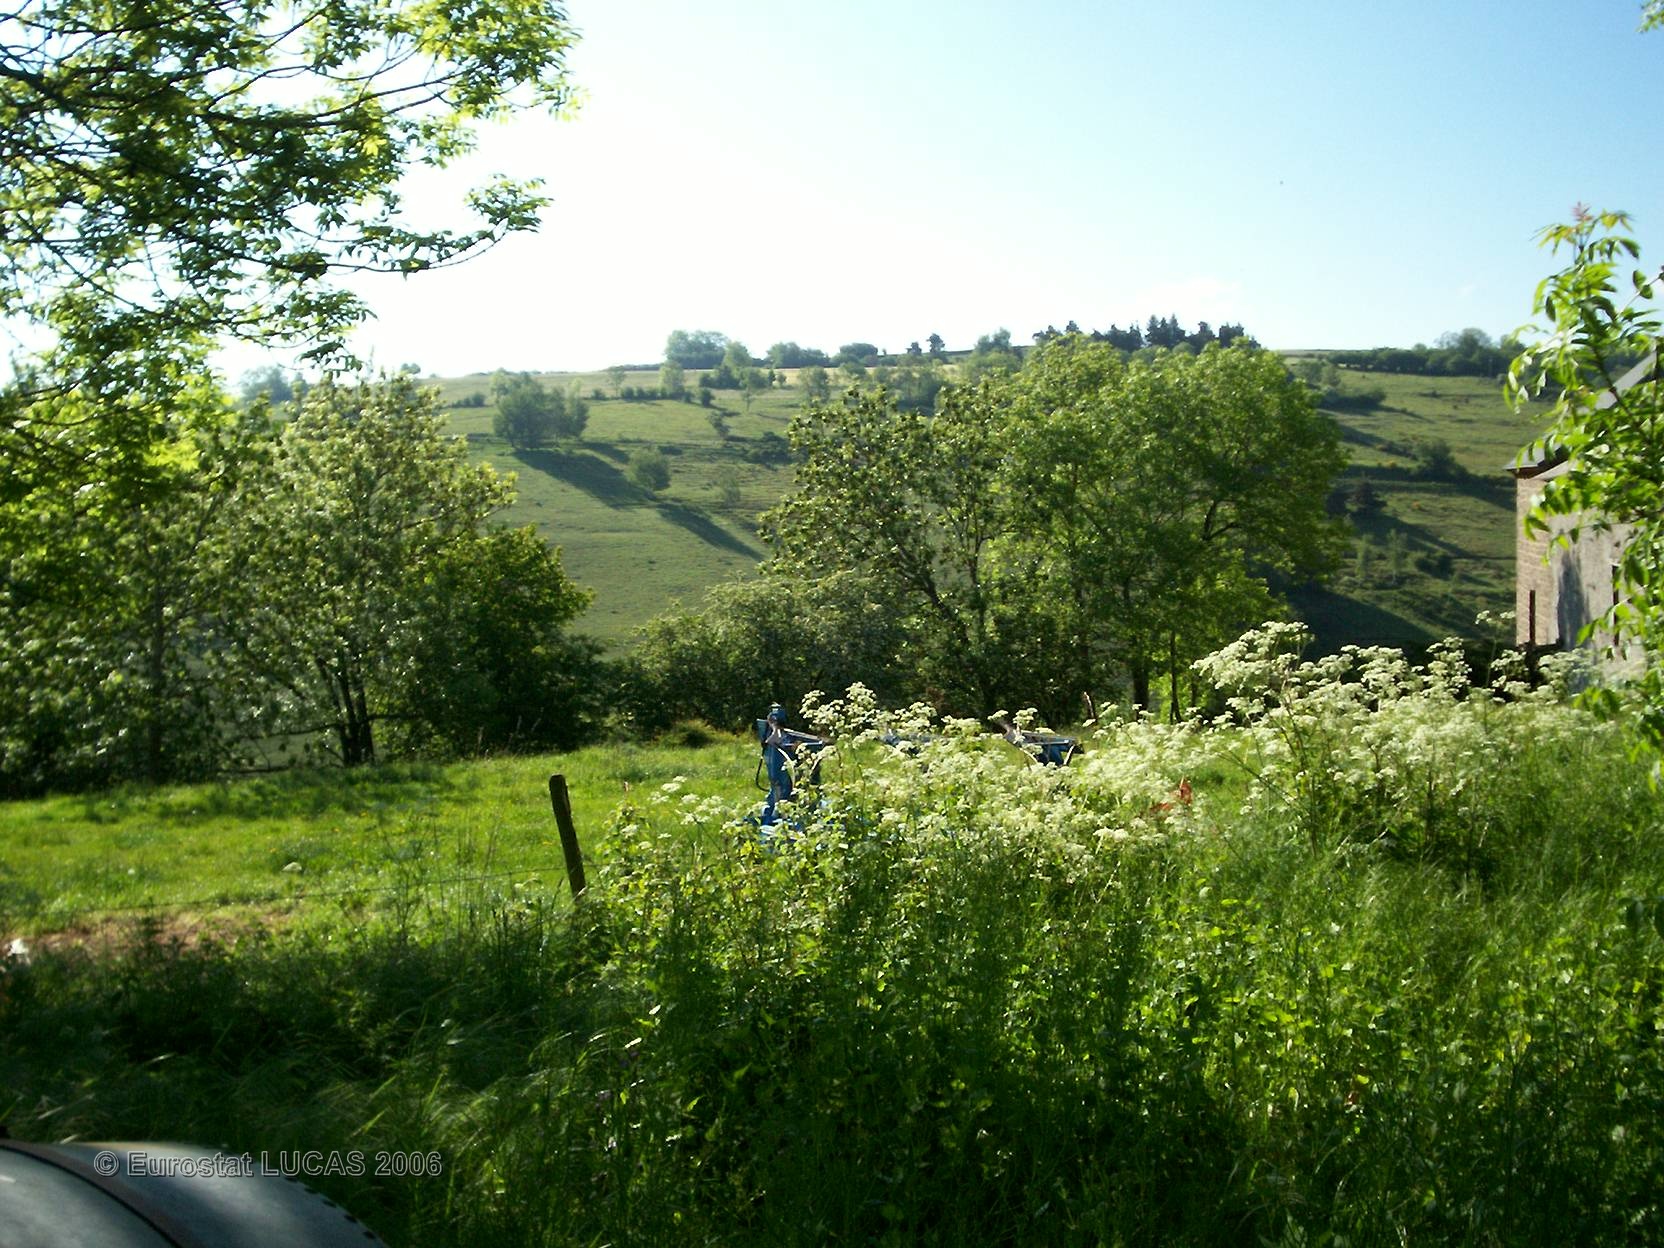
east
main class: Grassland
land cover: Grassland with sparse tree/shrub cover
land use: Agriculture (excluding fallow land and kitchen gardens)
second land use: Residential
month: June
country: FR
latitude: 45.1436
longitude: 3.2493
